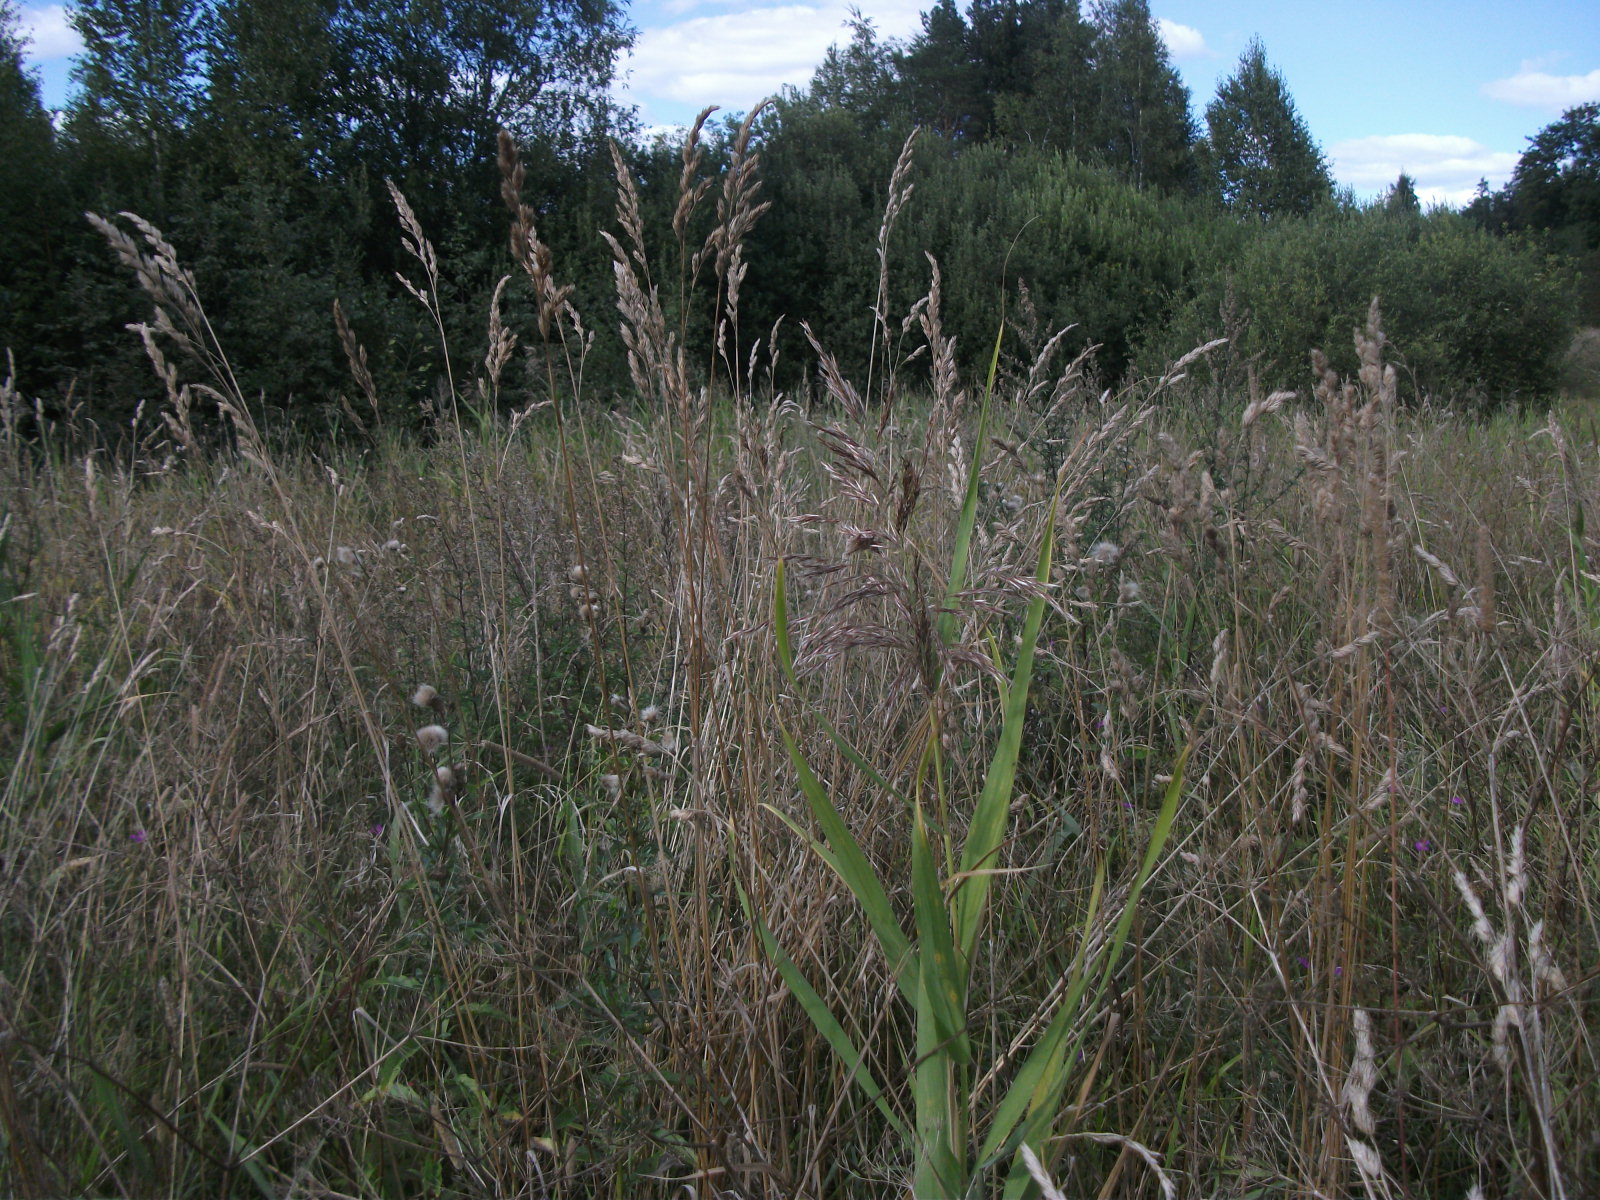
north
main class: Grassland
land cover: Spontaneously vegetated surfaces
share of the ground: > 75 %
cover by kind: herbaceous plants 95 %, shrubs 5 %
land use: Semi-natural and natural areas not in use
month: August
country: LV
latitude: 56.4176
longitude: 26.3374
